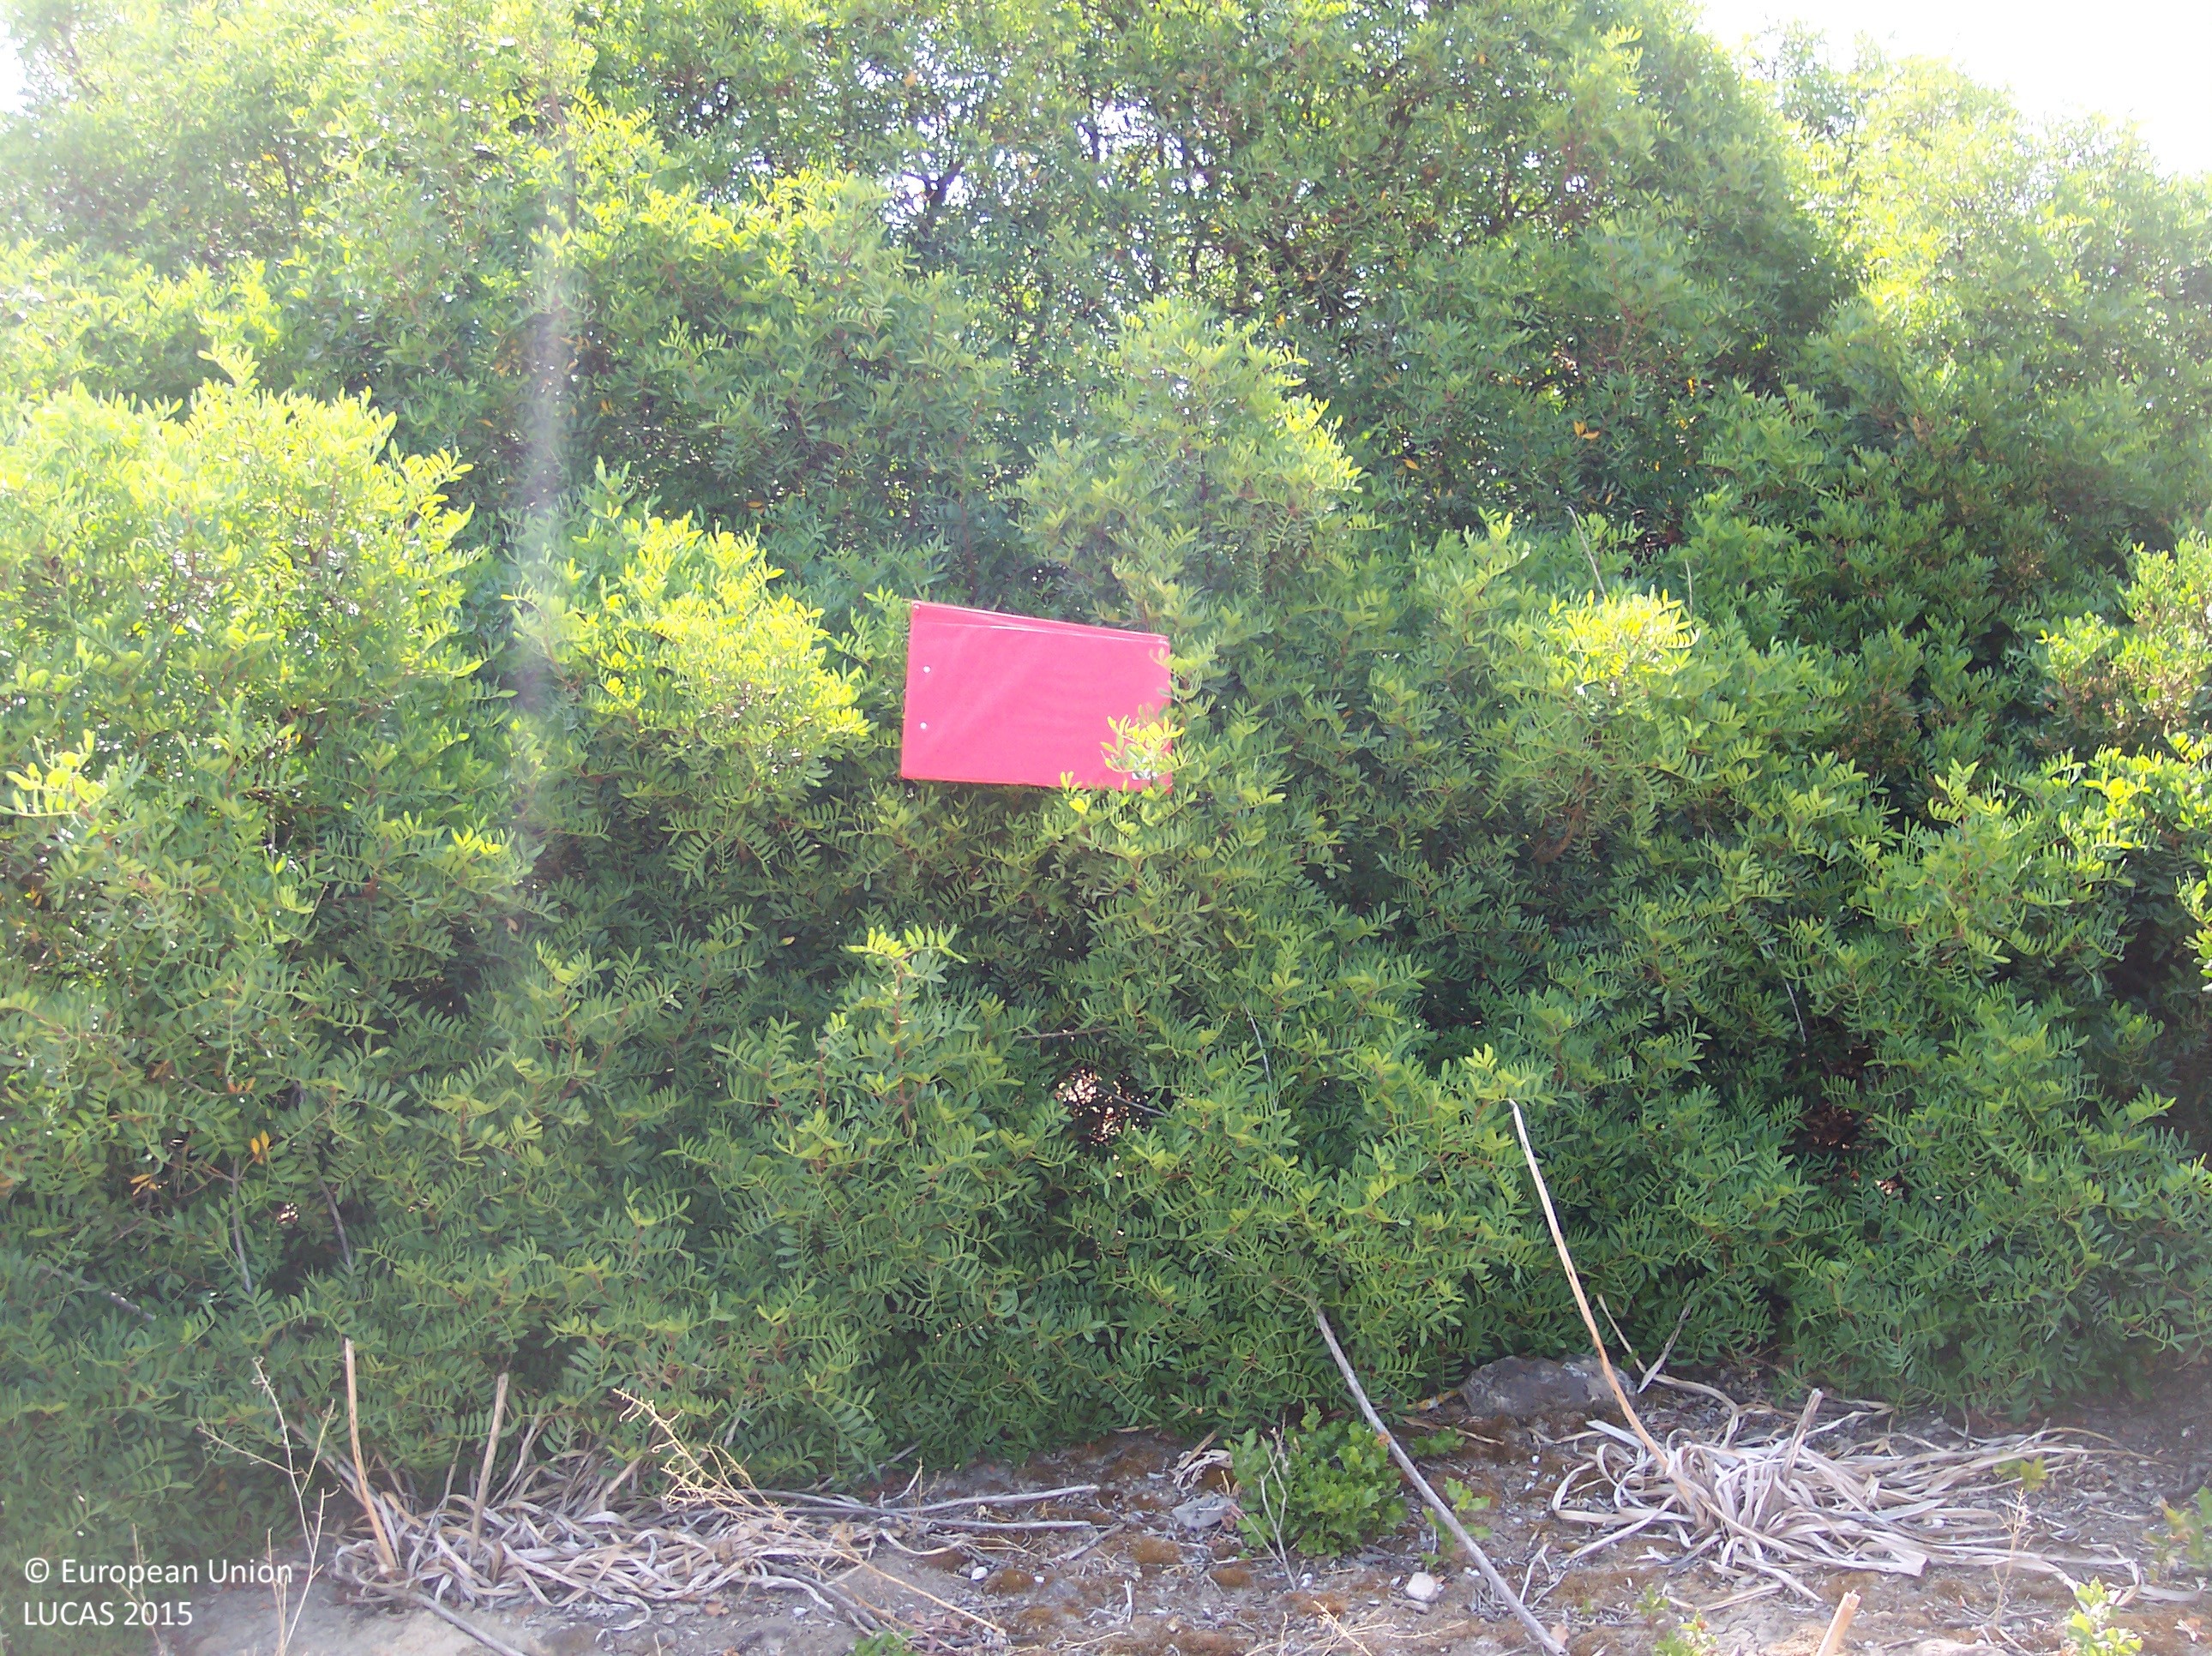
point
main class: Shrubland
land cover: Shrubland without tree cover
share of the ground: > 75 %
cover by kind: shrubs 90 %, herbaceous plants 5 %, unconsolidated bare surface 5 %
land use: Semi-natural and natural areas not in use
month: July
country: ES
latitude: 36.9893
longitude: -5.7987
